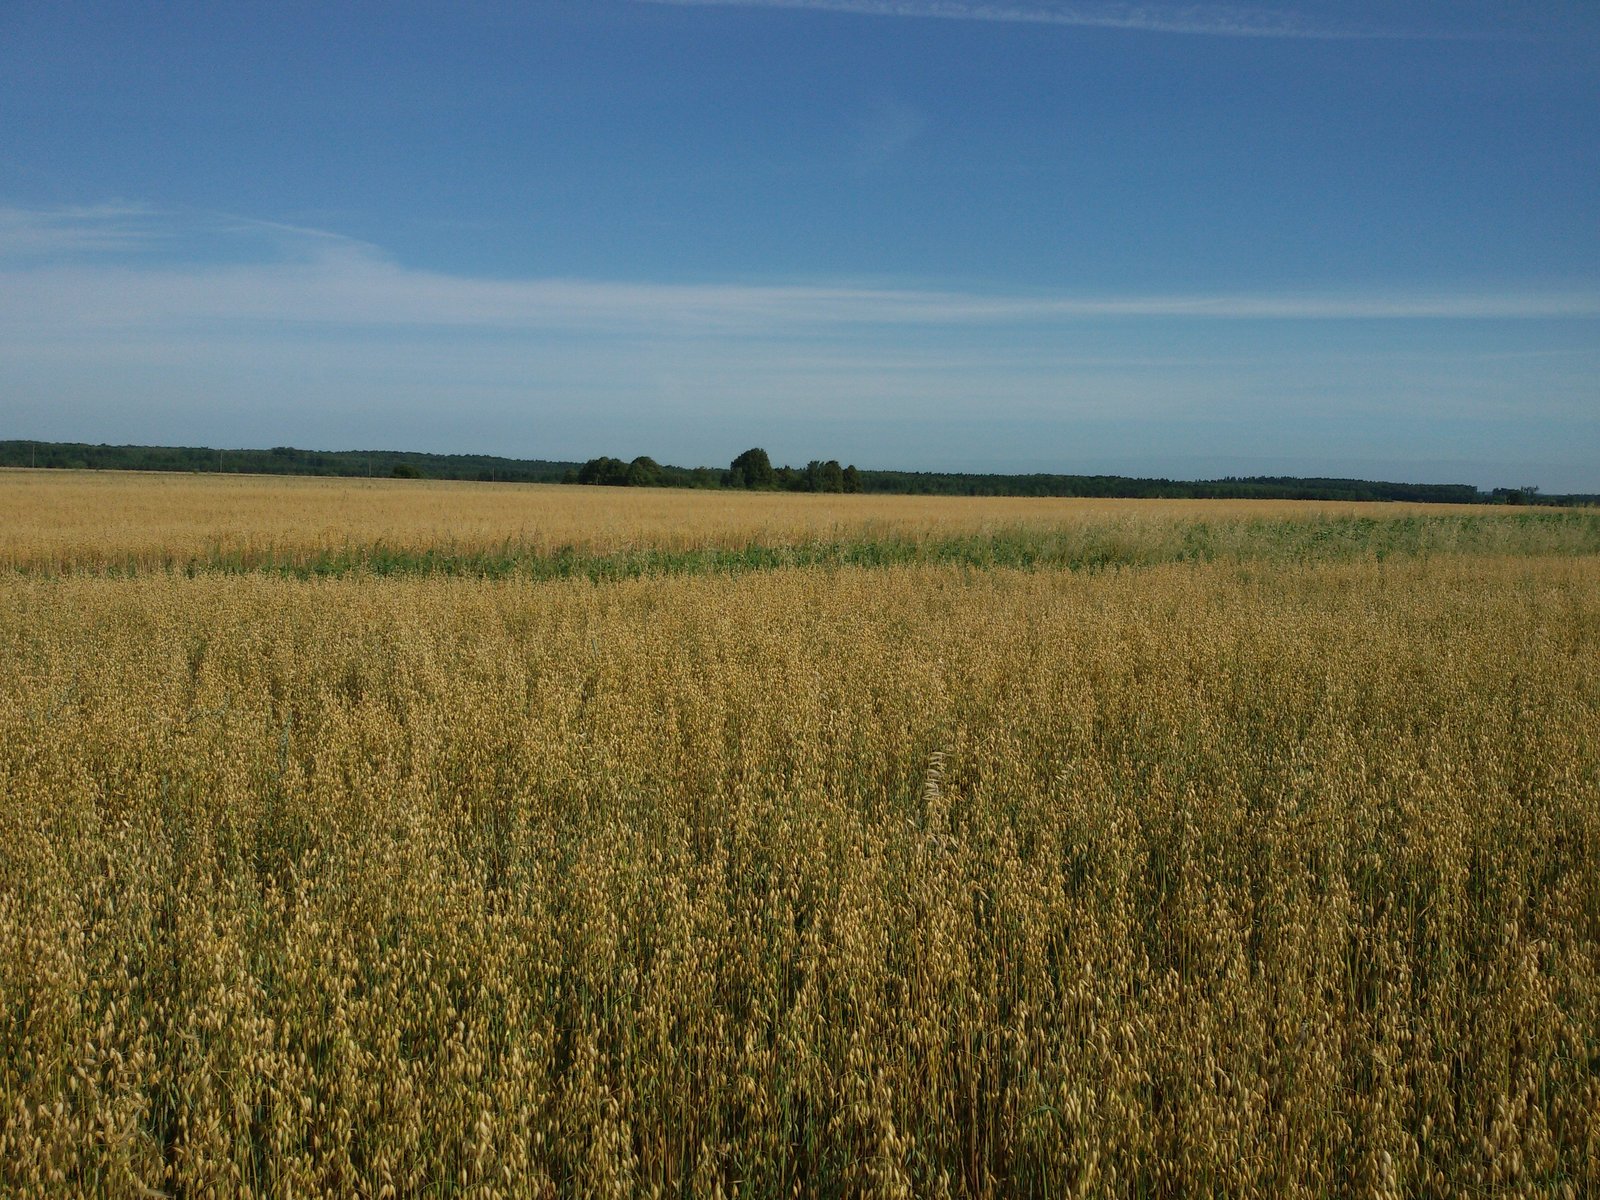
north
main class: Cropland
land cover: Oats
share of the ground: > 75 %
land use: Agriculture (excluding fallow land and kitchen gardens)
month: August
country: PL
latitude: 53.6069
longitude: 17.1281
